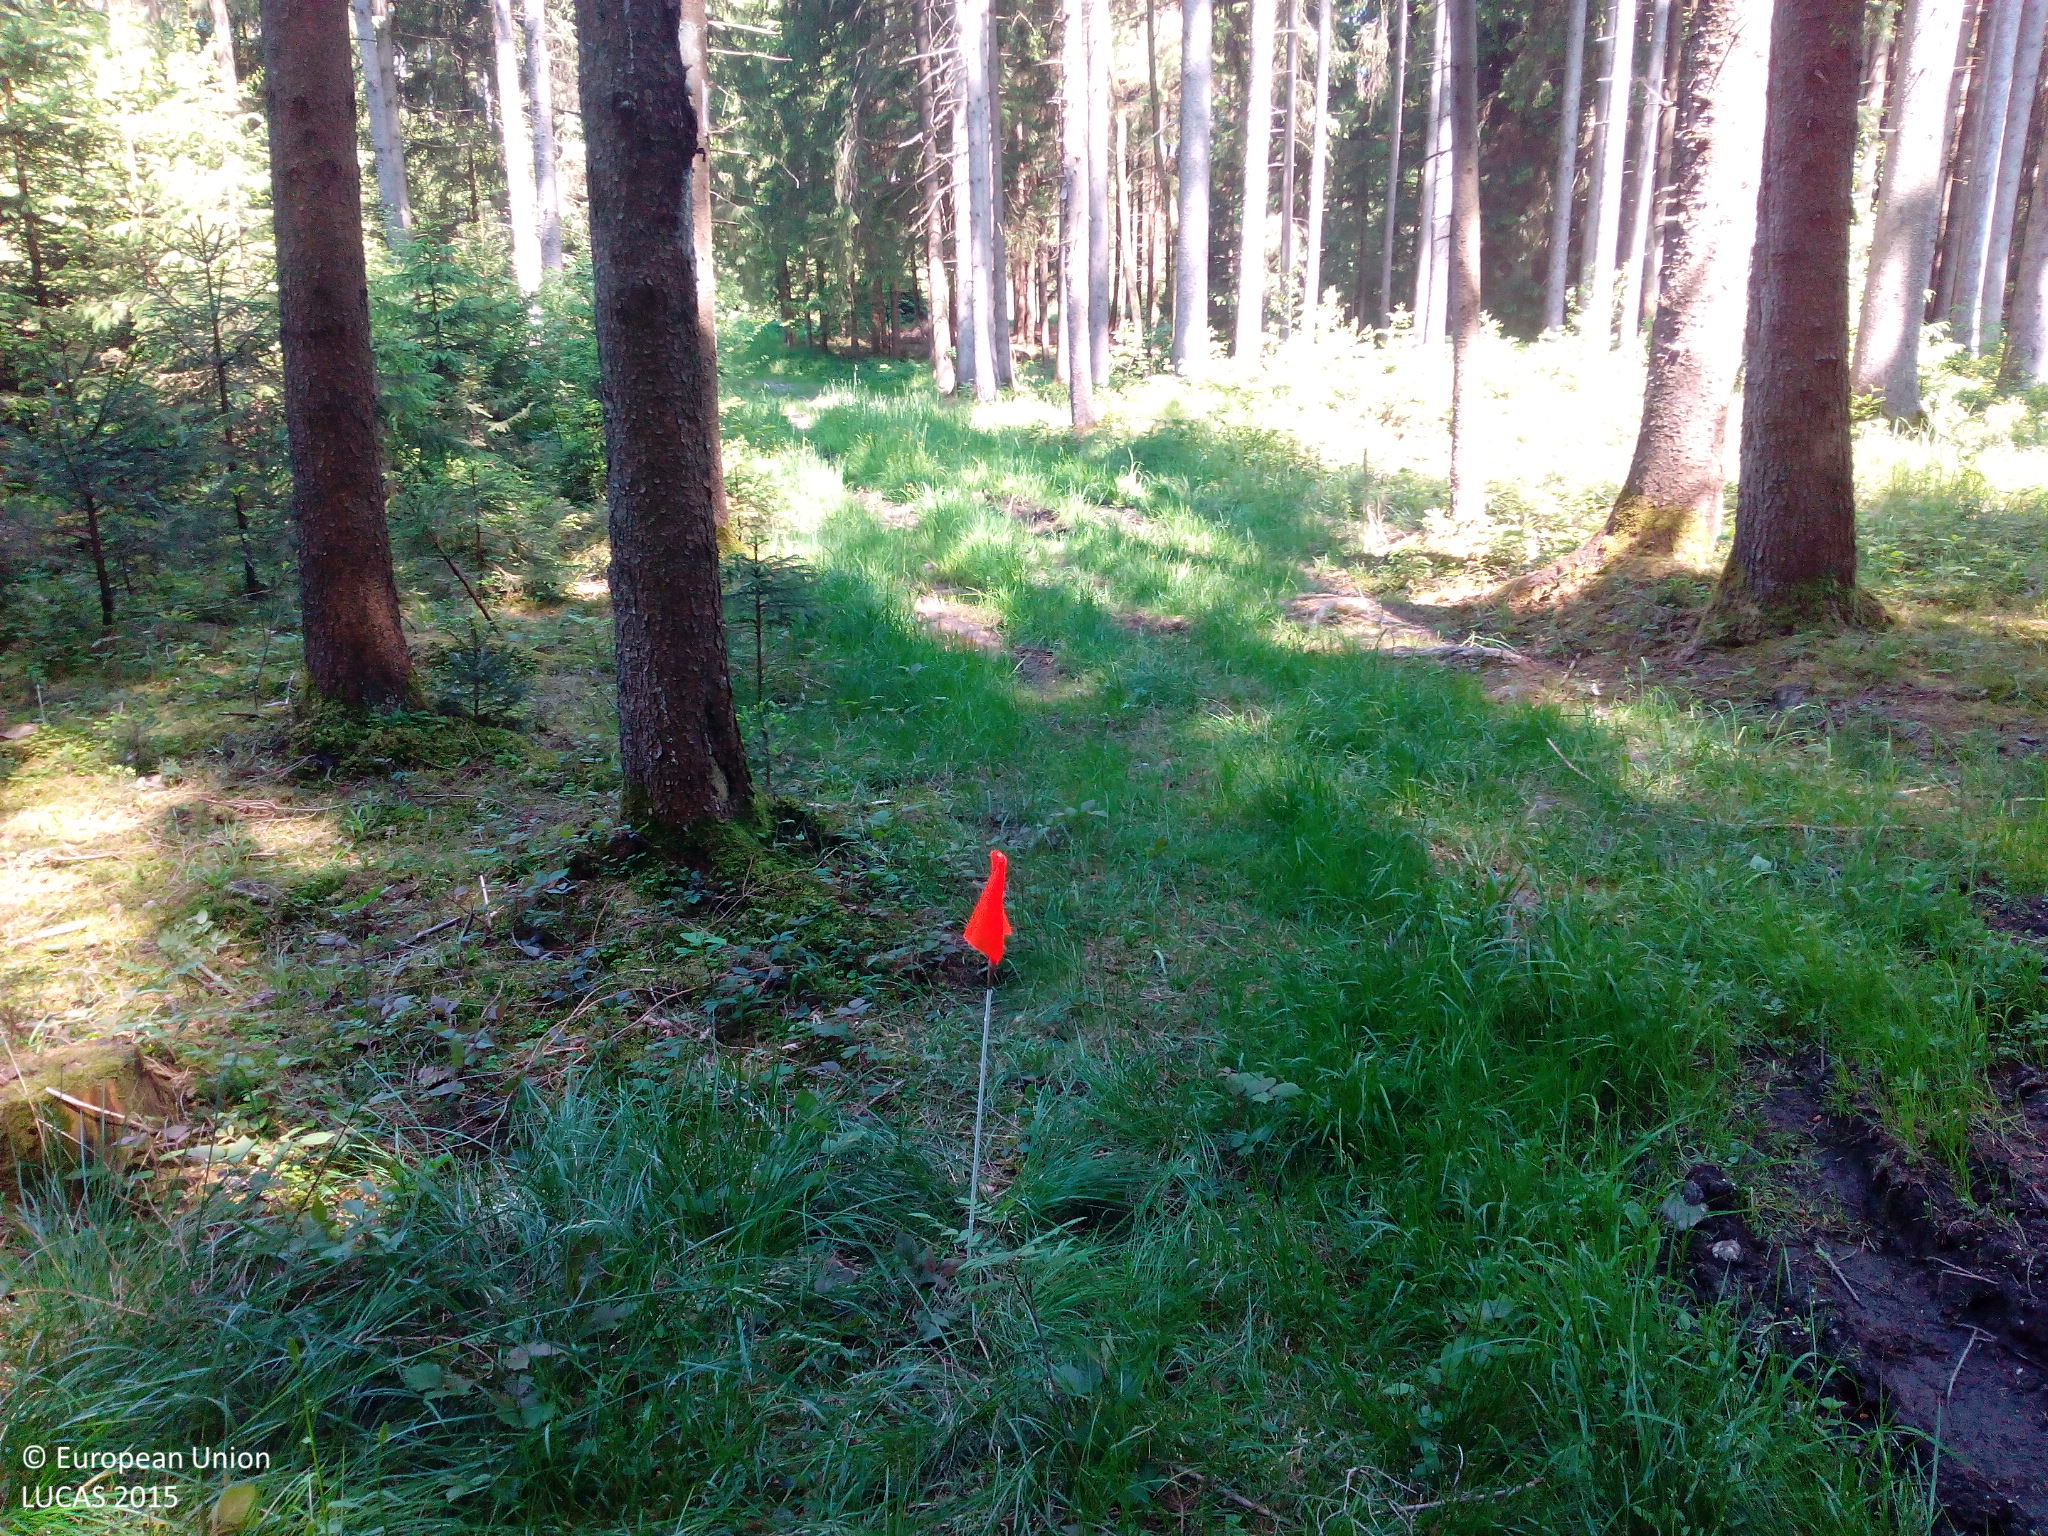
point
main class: Woodland
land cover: Spruce dominated coniferous woodland
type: hemiboreal forest and nemoral coniferous forest and mixed broadleaved-coniferous forest
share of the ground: > 75 %
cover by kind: coniferous forest trees 100 %
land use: Forestry
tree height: > 5 m
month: June
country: DE
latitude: 47.8093
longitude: 10.2535
